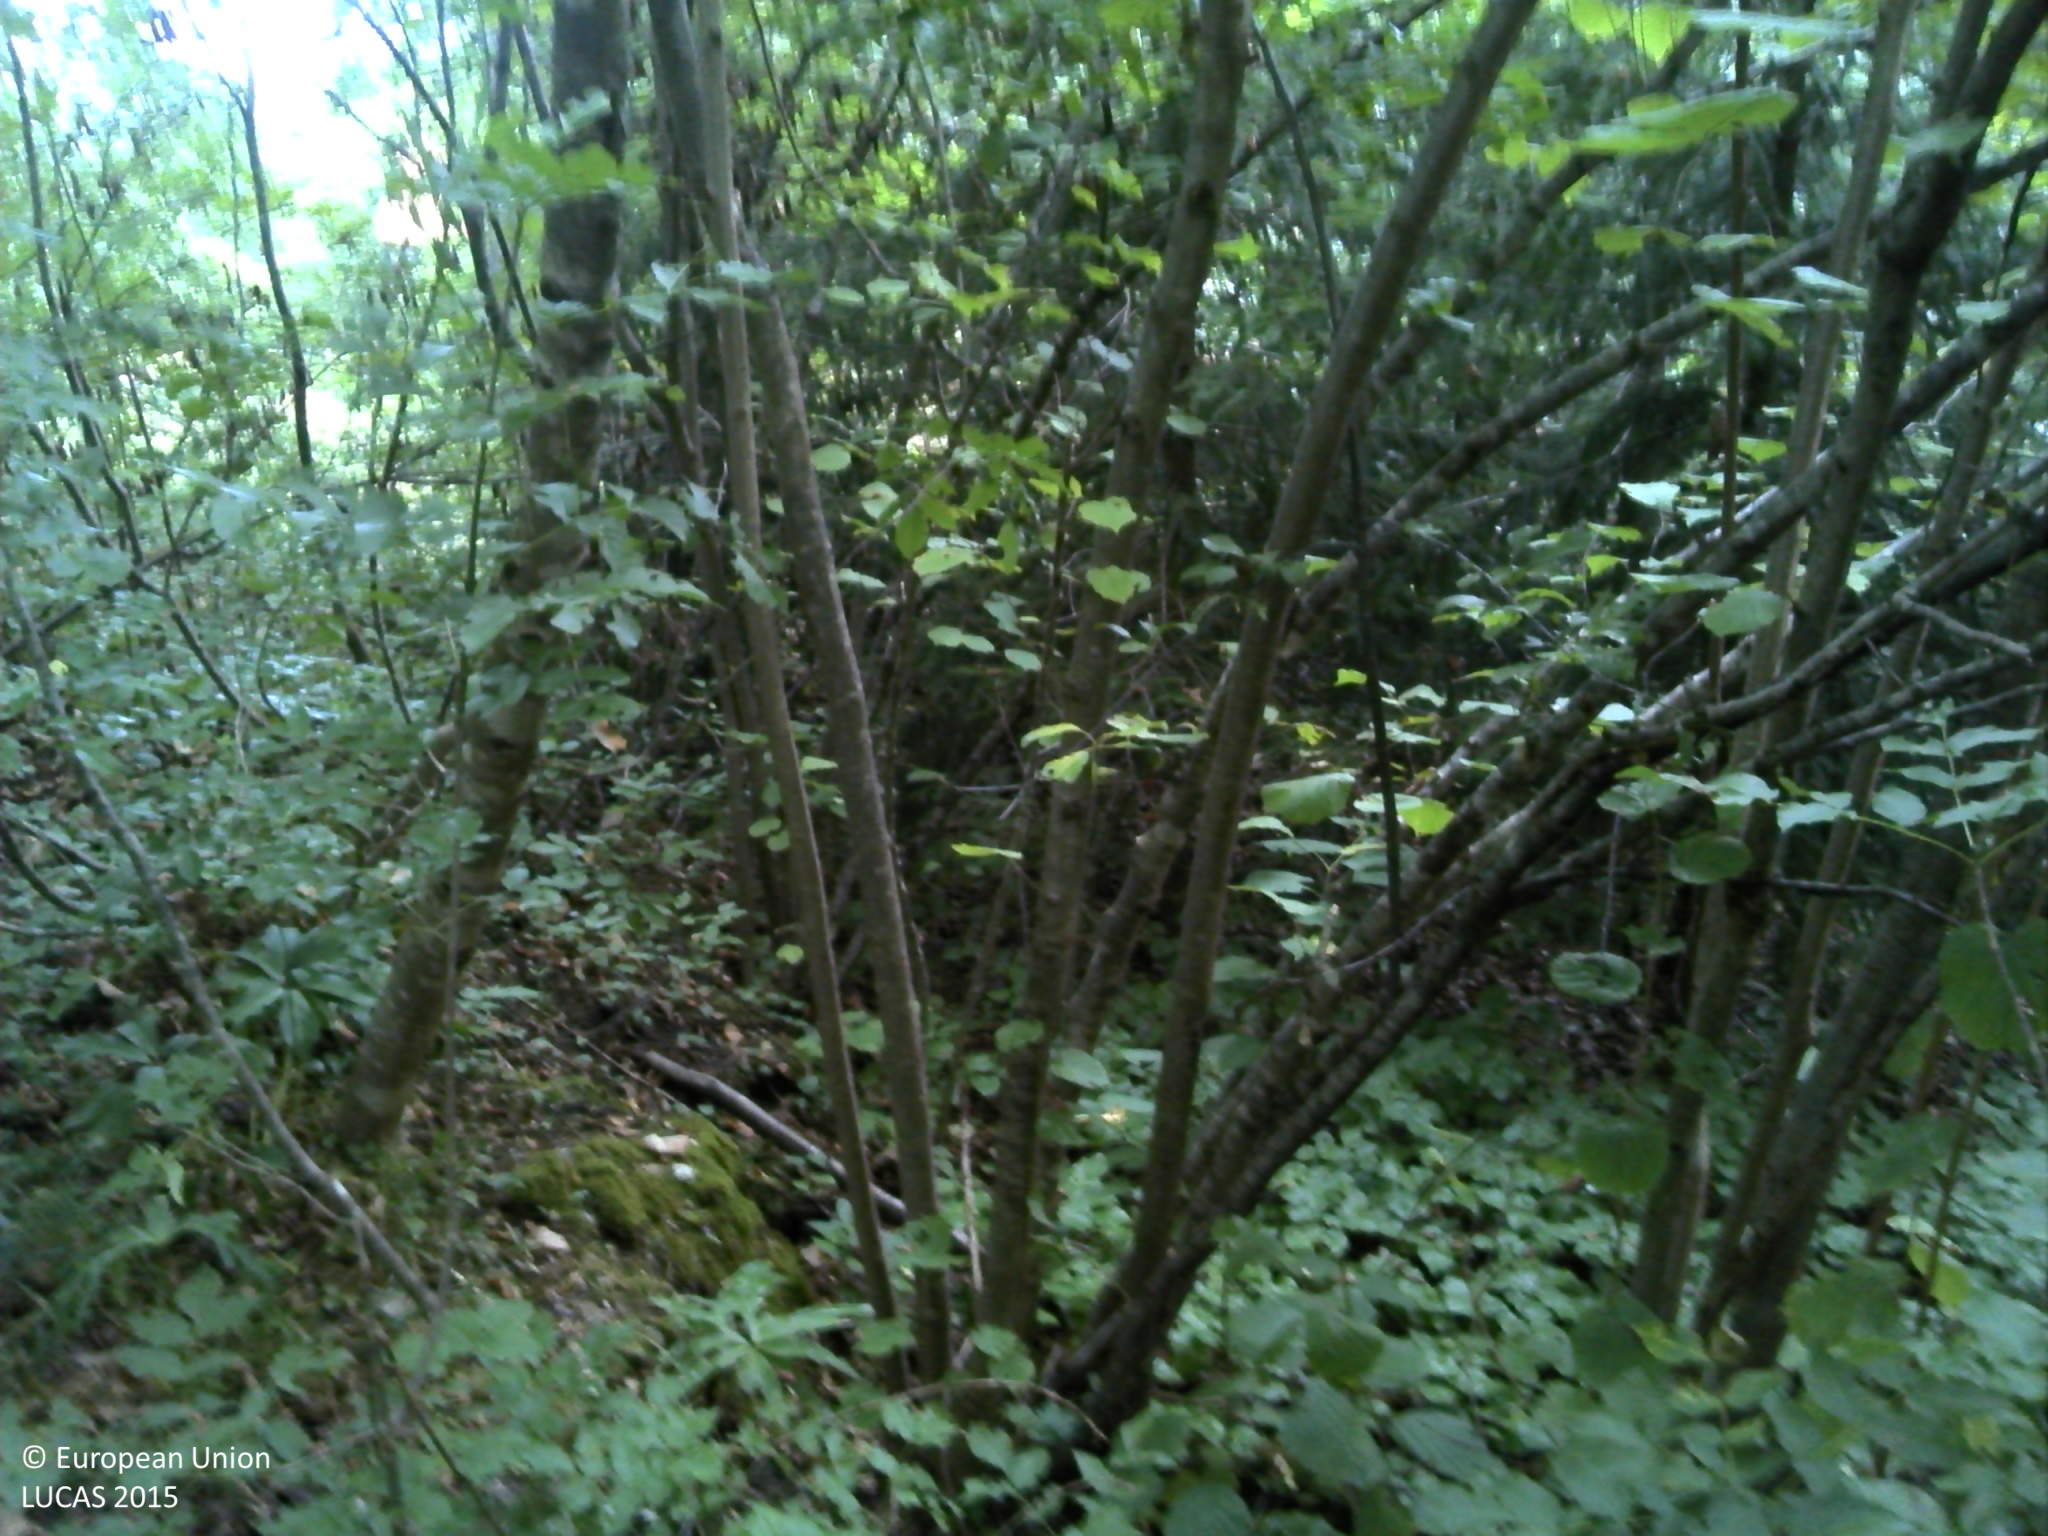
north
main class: Woodland
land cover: Broadleaved woodland
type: beech forest
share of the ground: > 75 %
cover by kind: broadleaved forest trees 100 %
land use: Forestry
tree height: > 5 m
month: September
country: HR
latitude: 45.2868
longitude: 15.1844
